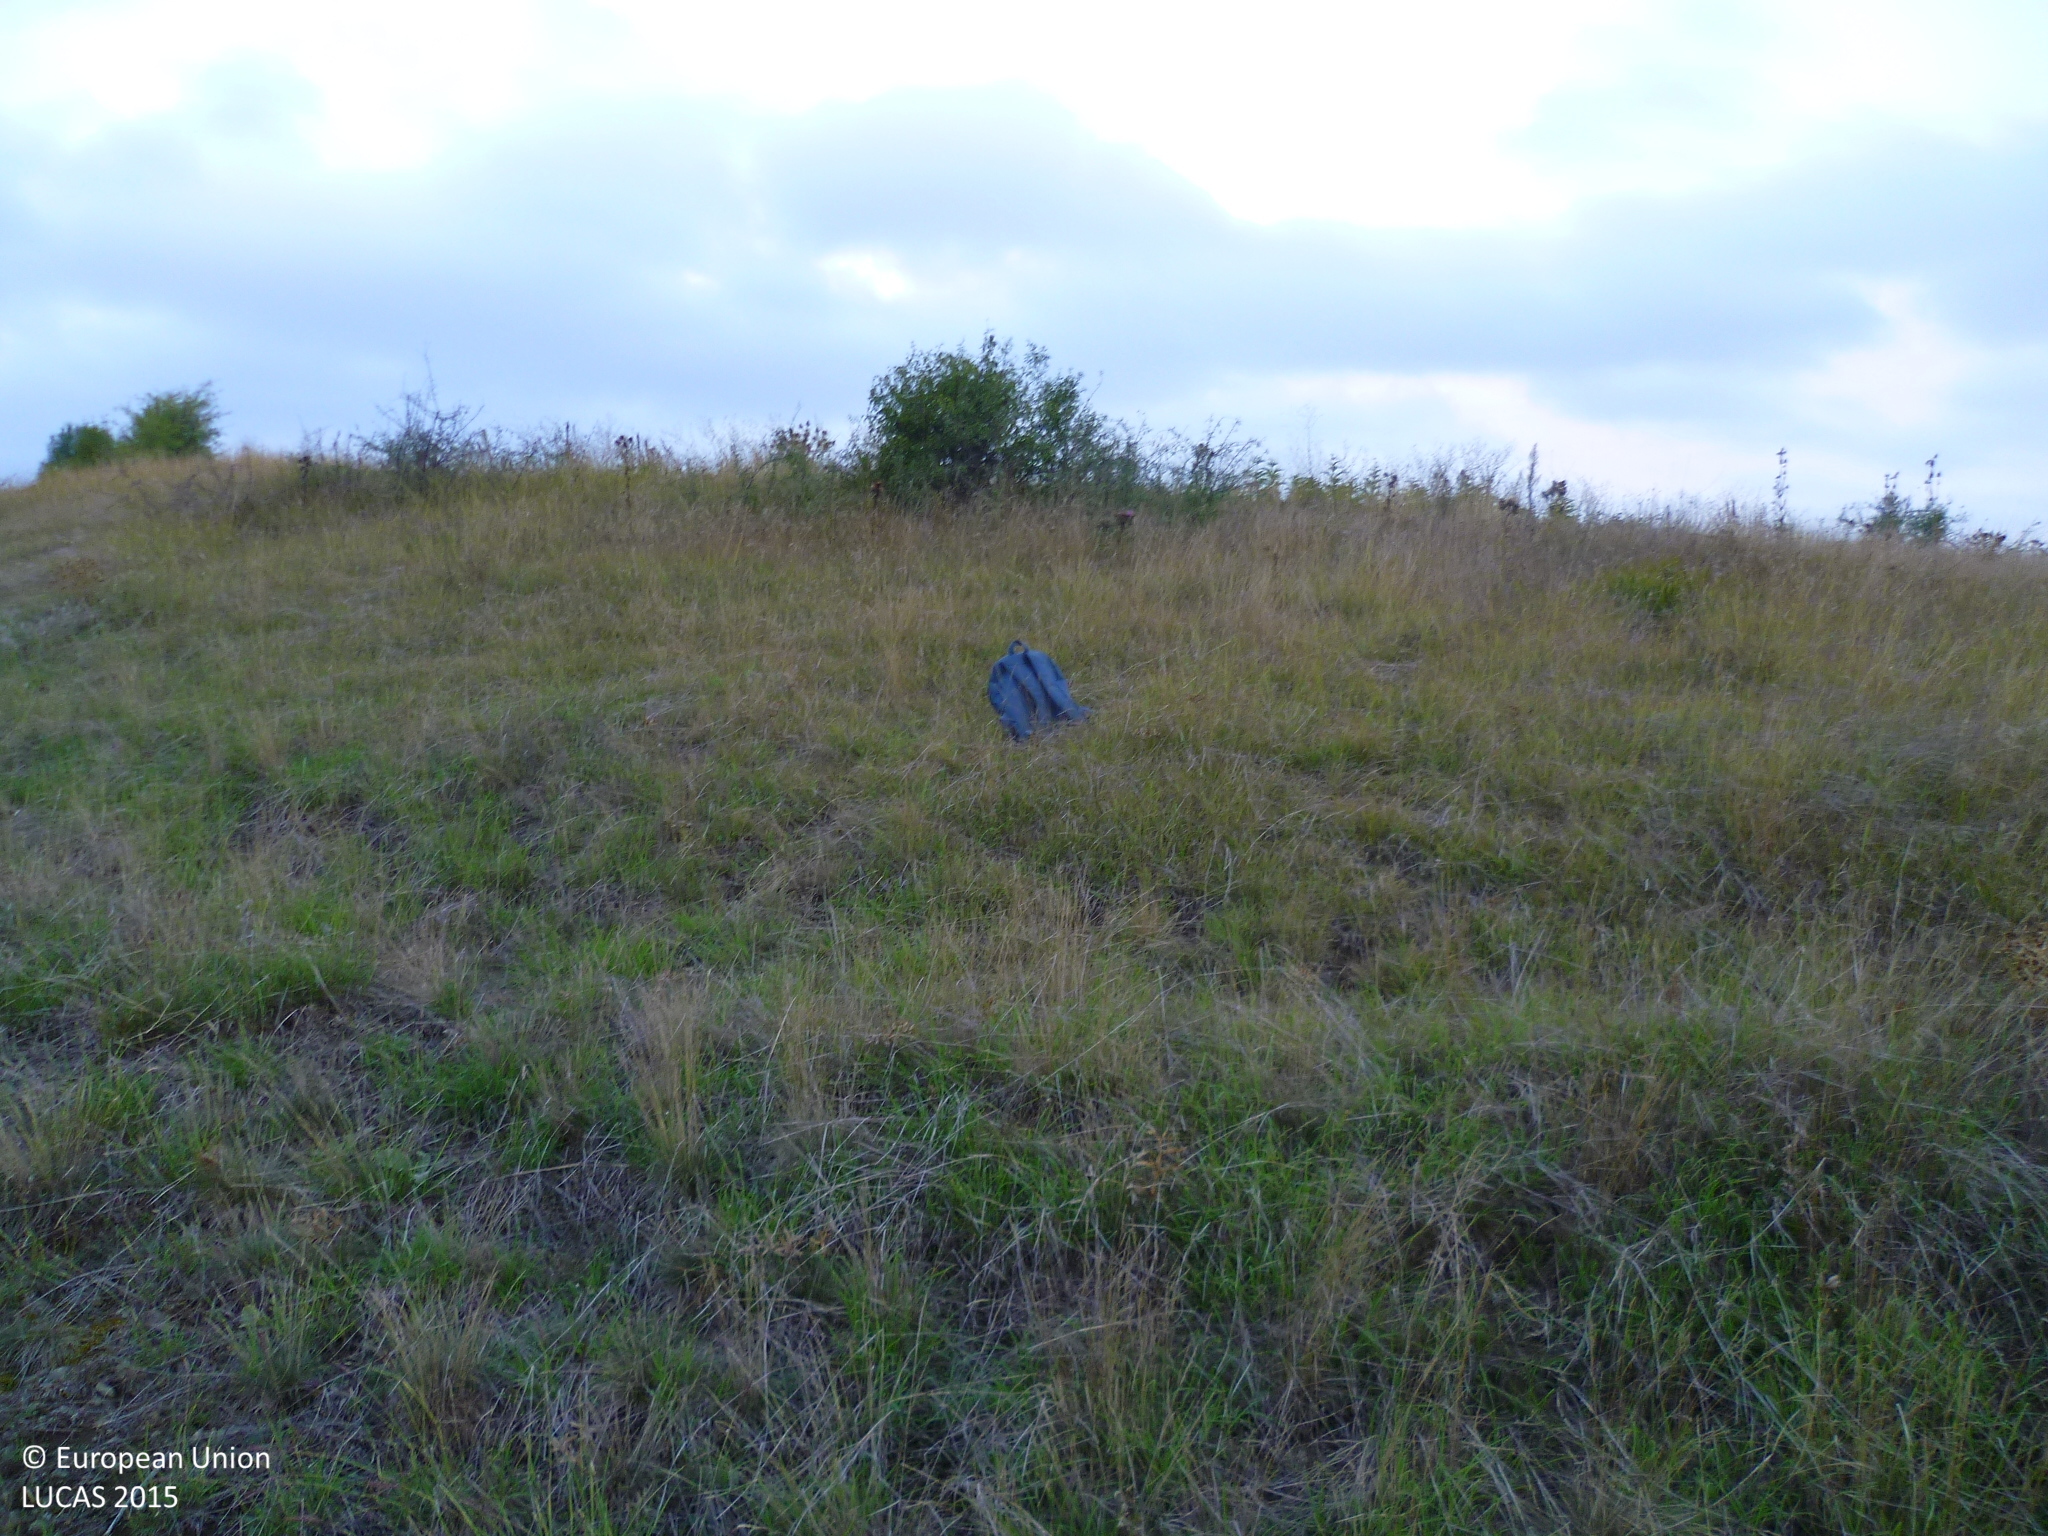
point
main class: Grassland
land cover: Grassland without tree/shrub cover
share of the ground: > 75 %
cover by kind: herbaceous plants 100 %
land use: Agriculture (excluding fallow land and kitchen gardens)
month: September
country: BG
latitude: 42.7888
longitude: 23.0757
